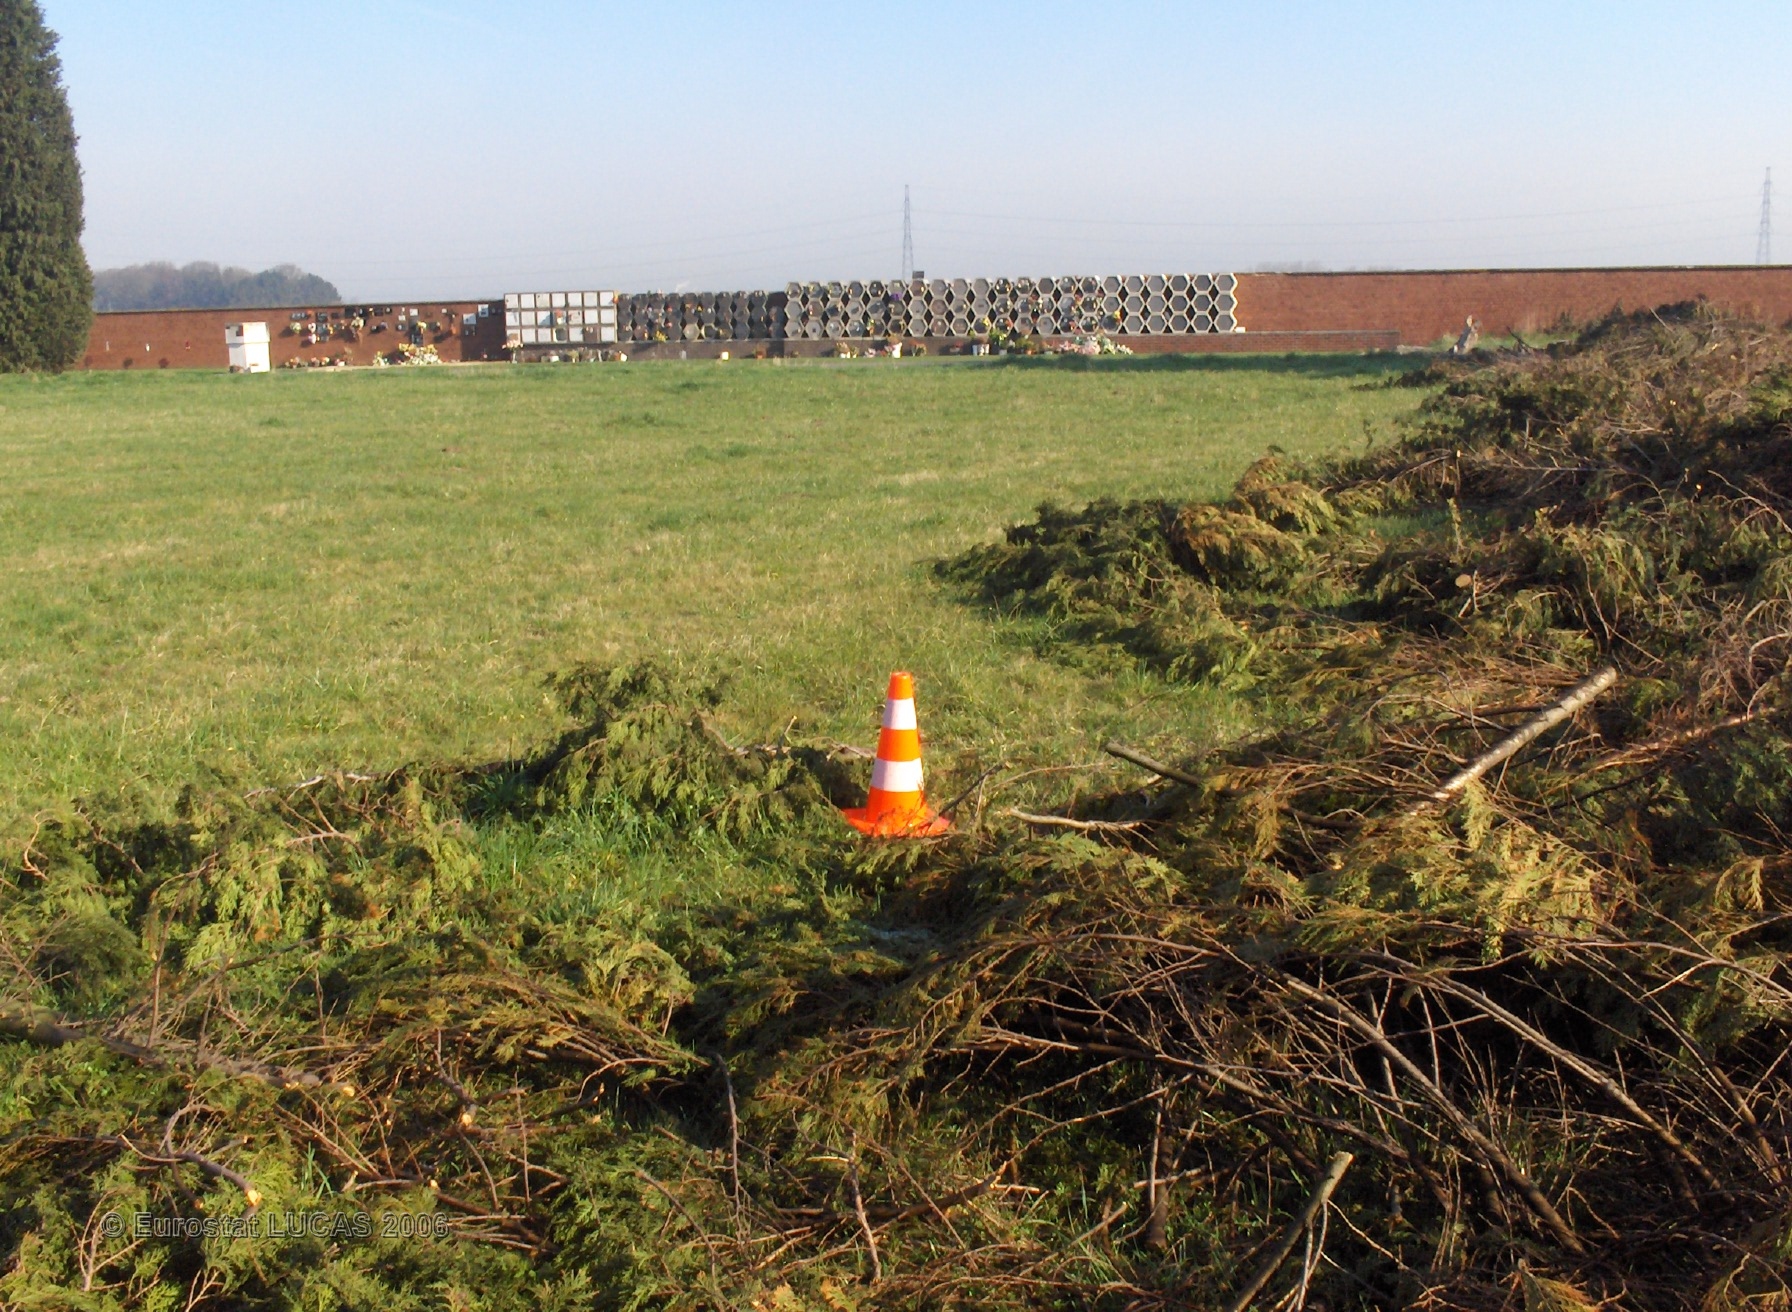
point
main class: Grassland
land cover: Grassland without tree/shrub cover
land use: Community services
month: April
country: BE
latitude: 50.4861
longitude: 4.5415
